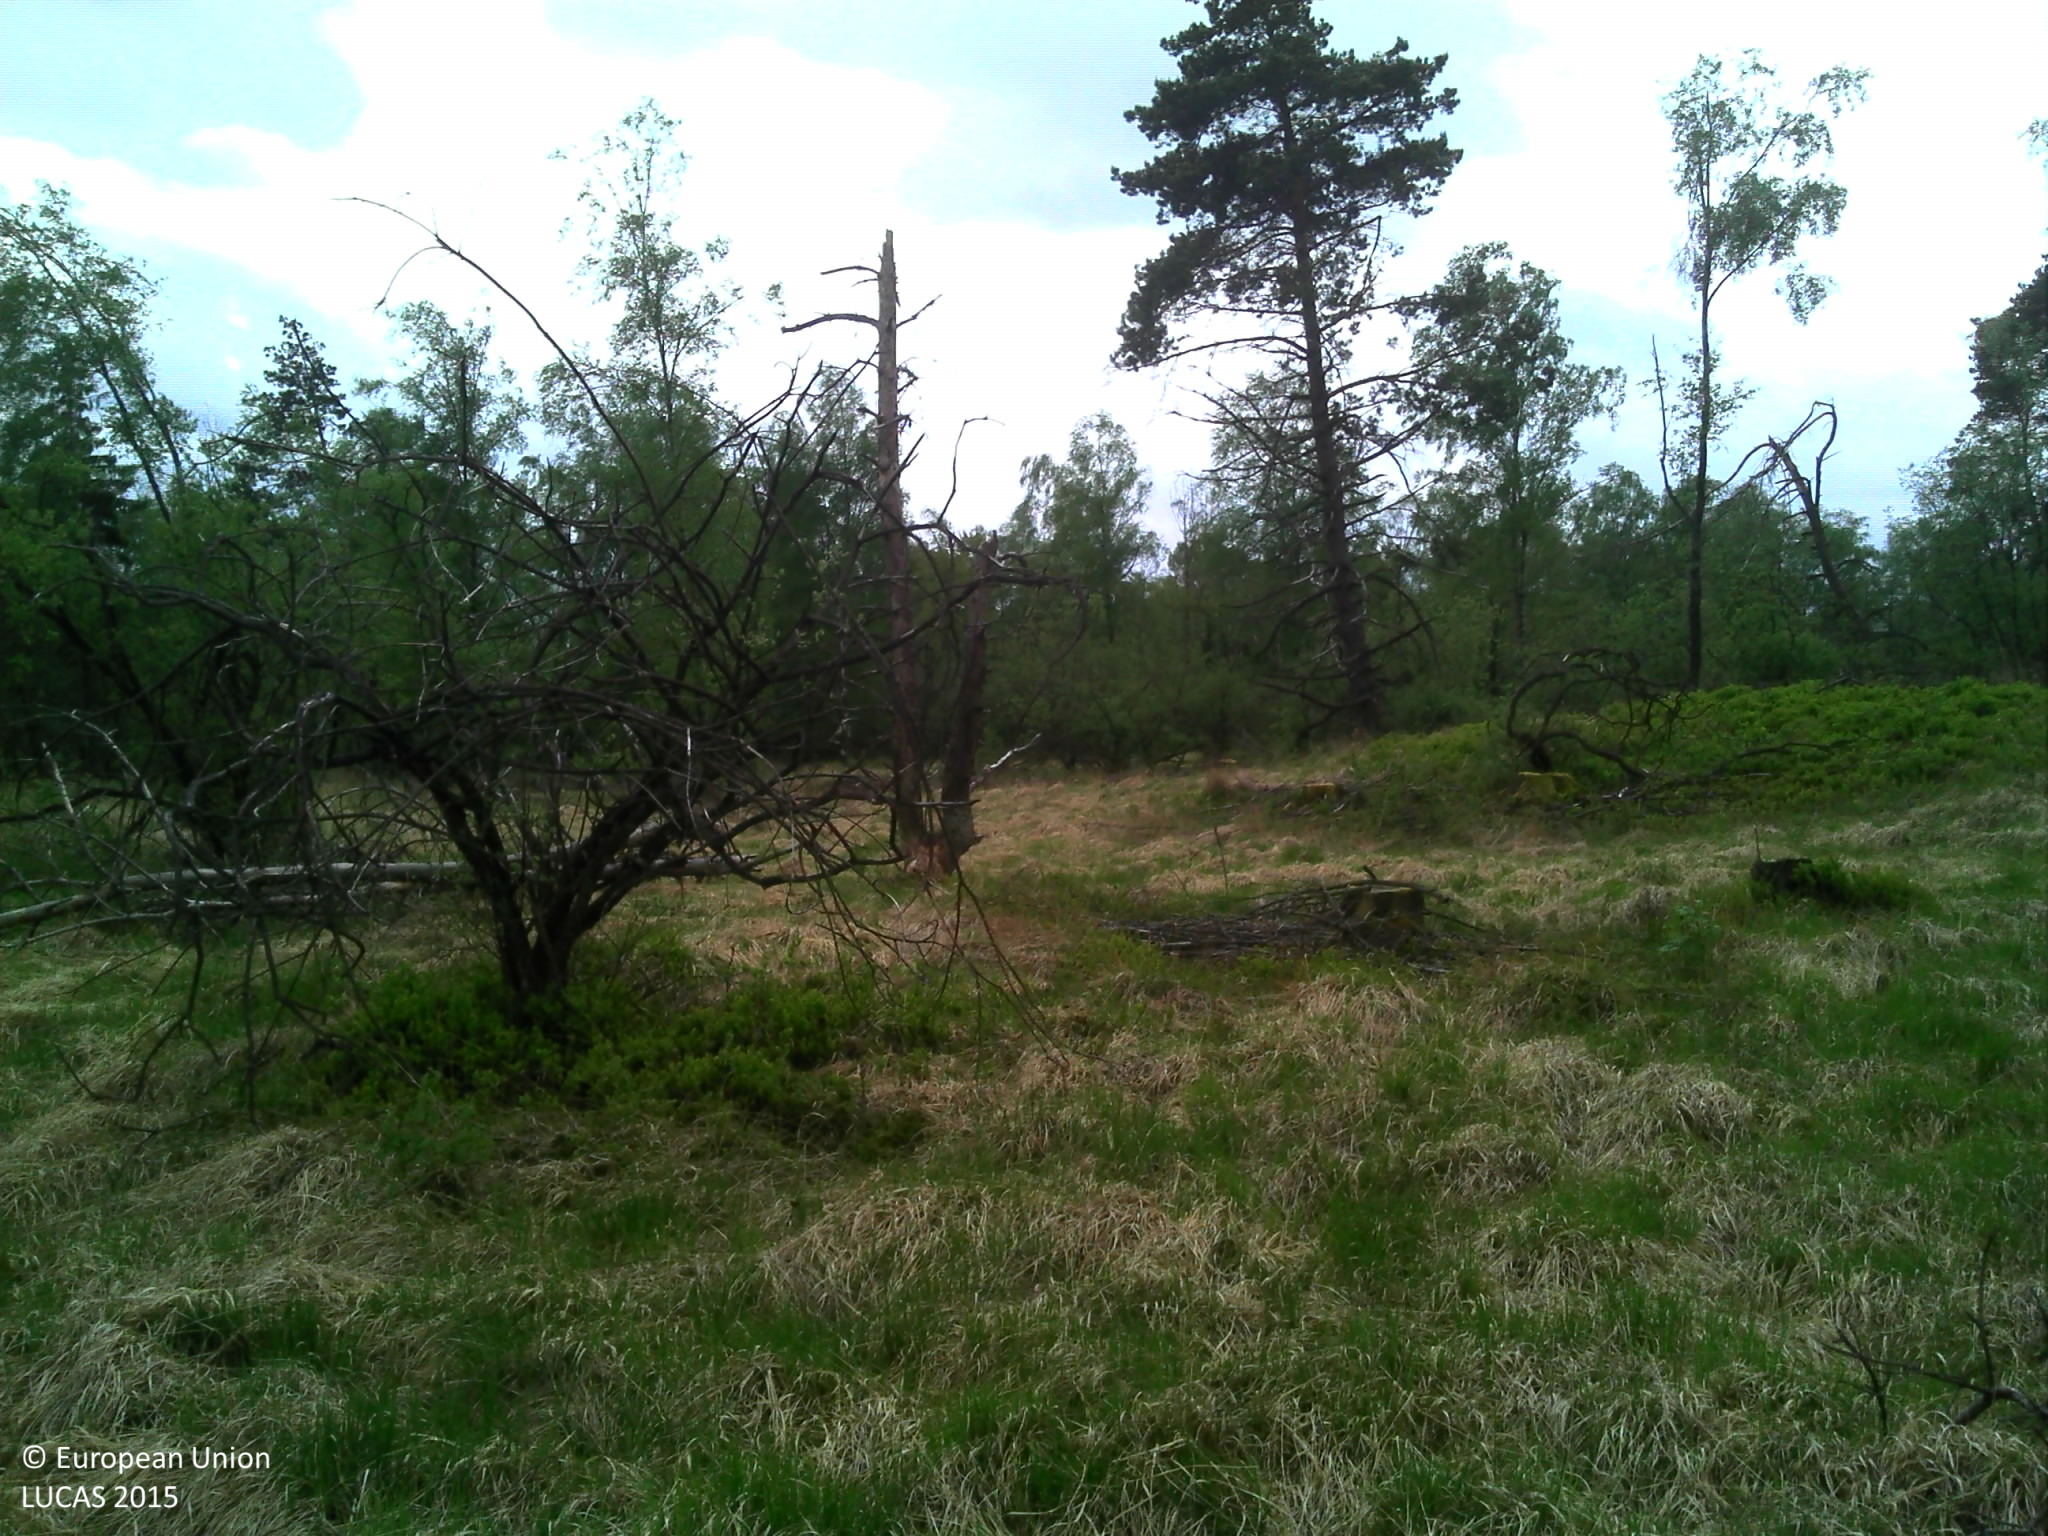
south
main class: Shrubland
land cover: Shrubland with sparse tree cover
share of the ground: > 75 %
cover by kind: herbaceous plants 80 %, shrubs 15 %, broadleaved forest trees 5 %
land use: Forestry
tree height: > 5 m
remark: Temporary flooded
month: May
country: BE
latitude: 50.6088
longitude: 6.2546
